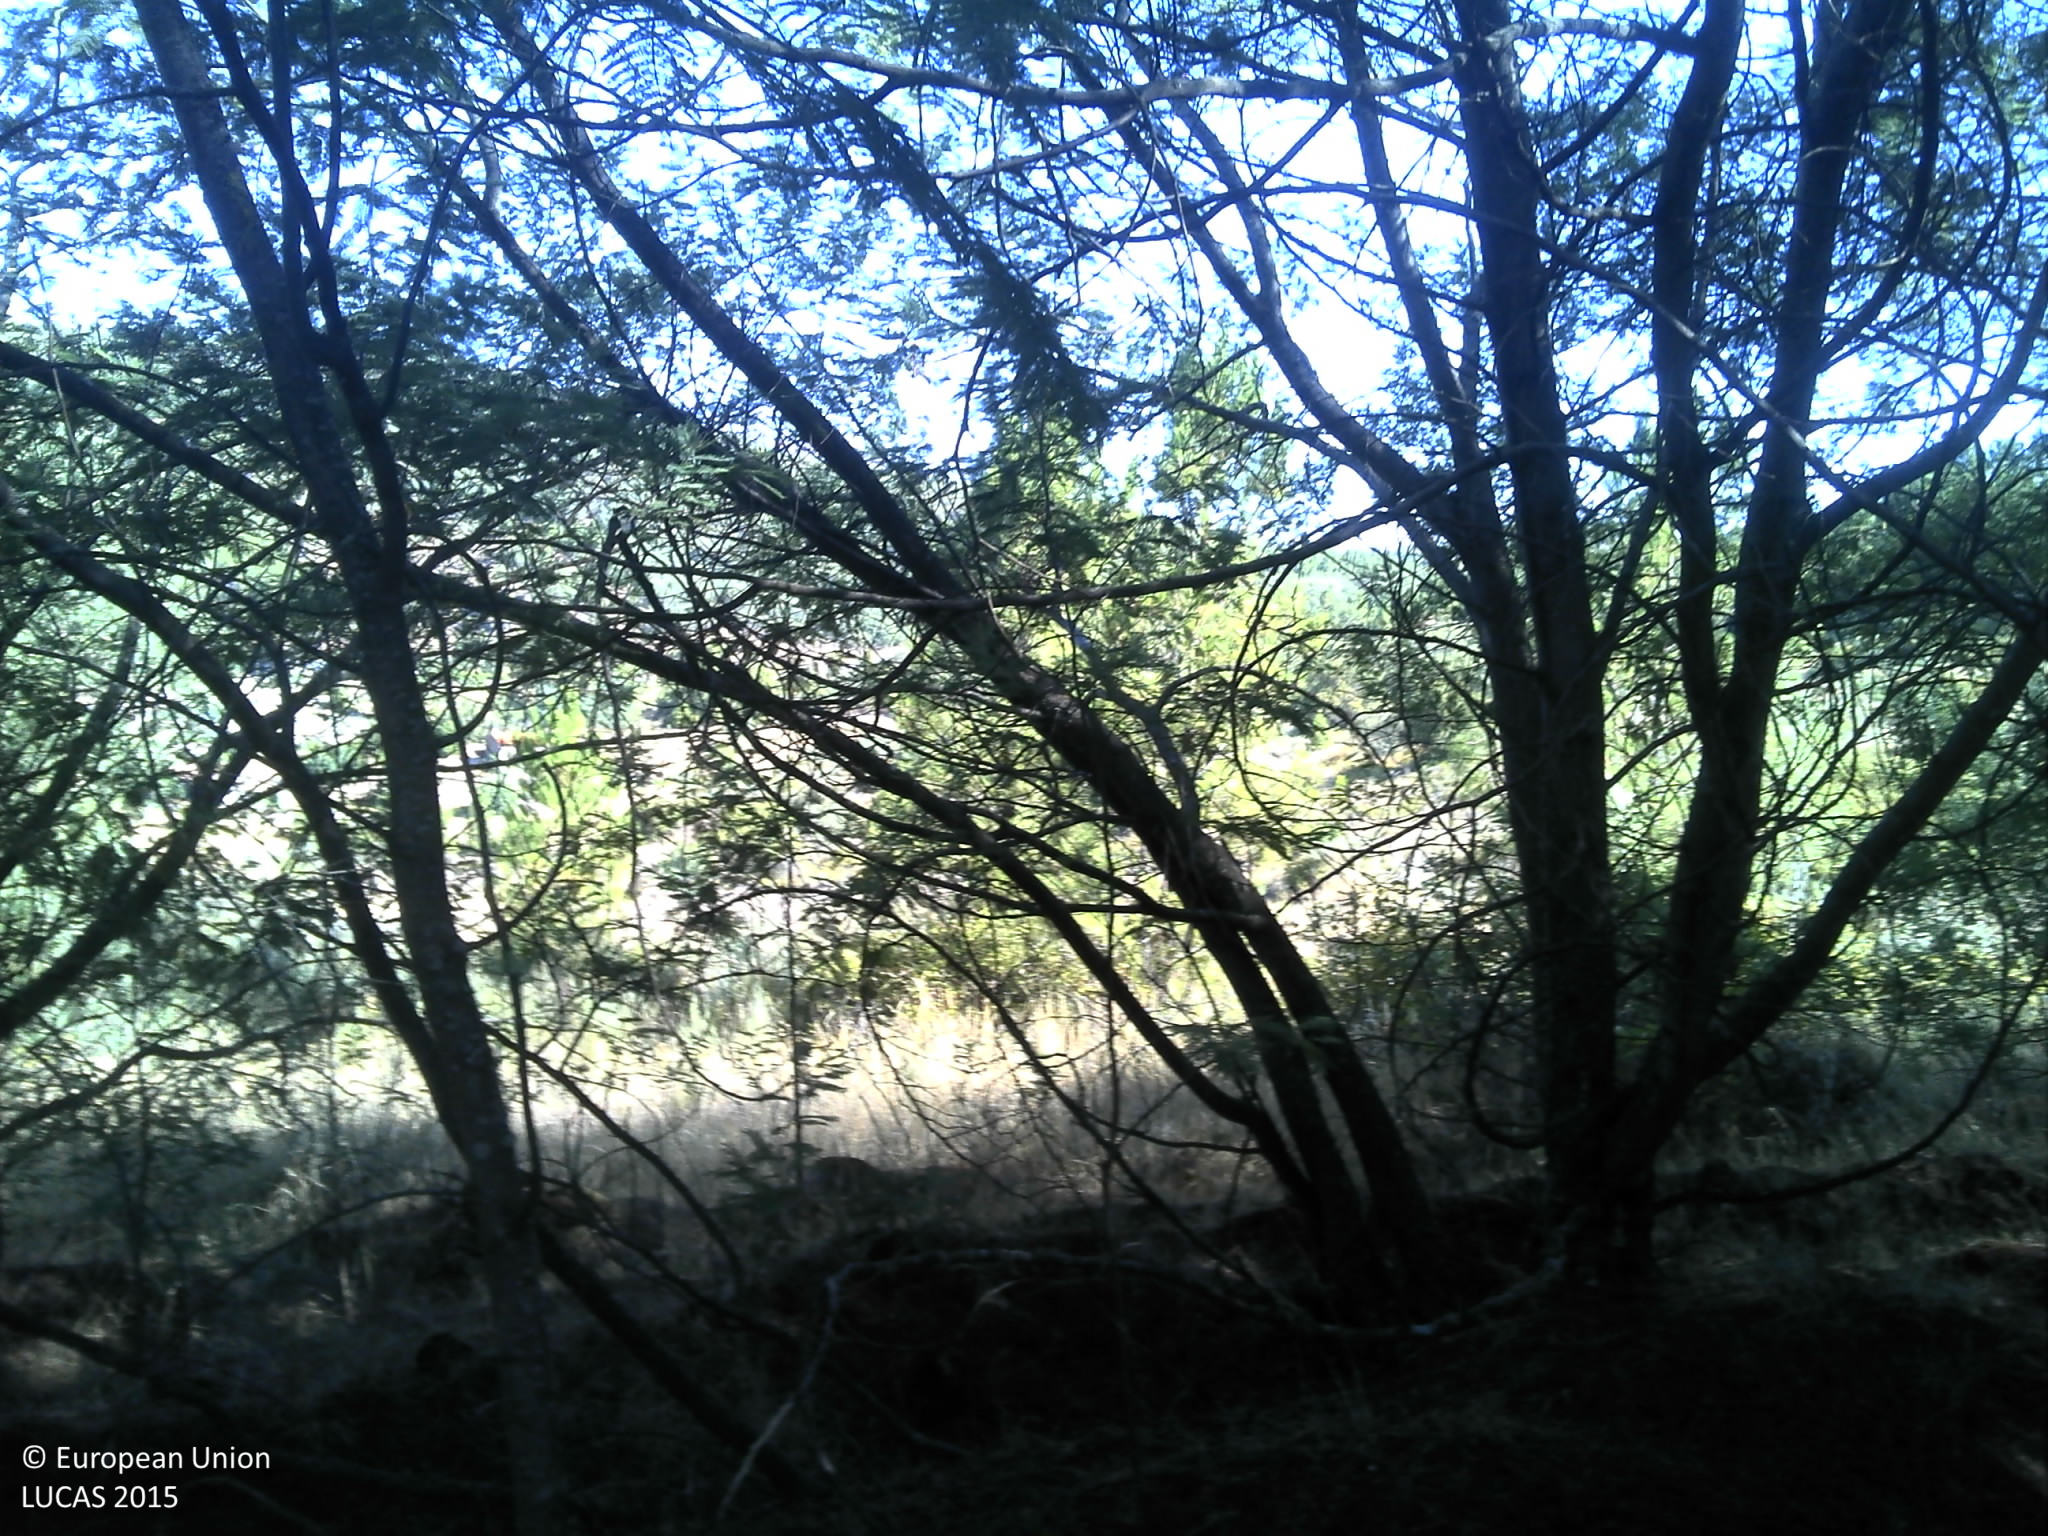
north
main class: Woodland
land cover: Broadleaved woodland
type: exotic forest
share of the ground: 50 - 75 %
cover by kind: broadleaved forest trees 60 %, shrubs 20 %, unconsolidated bare surface 10 %, herbaceous plants 5 %
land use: Forestry
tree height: > 5 m
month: July
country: PT
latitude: 40.3931
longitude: -7.3168
